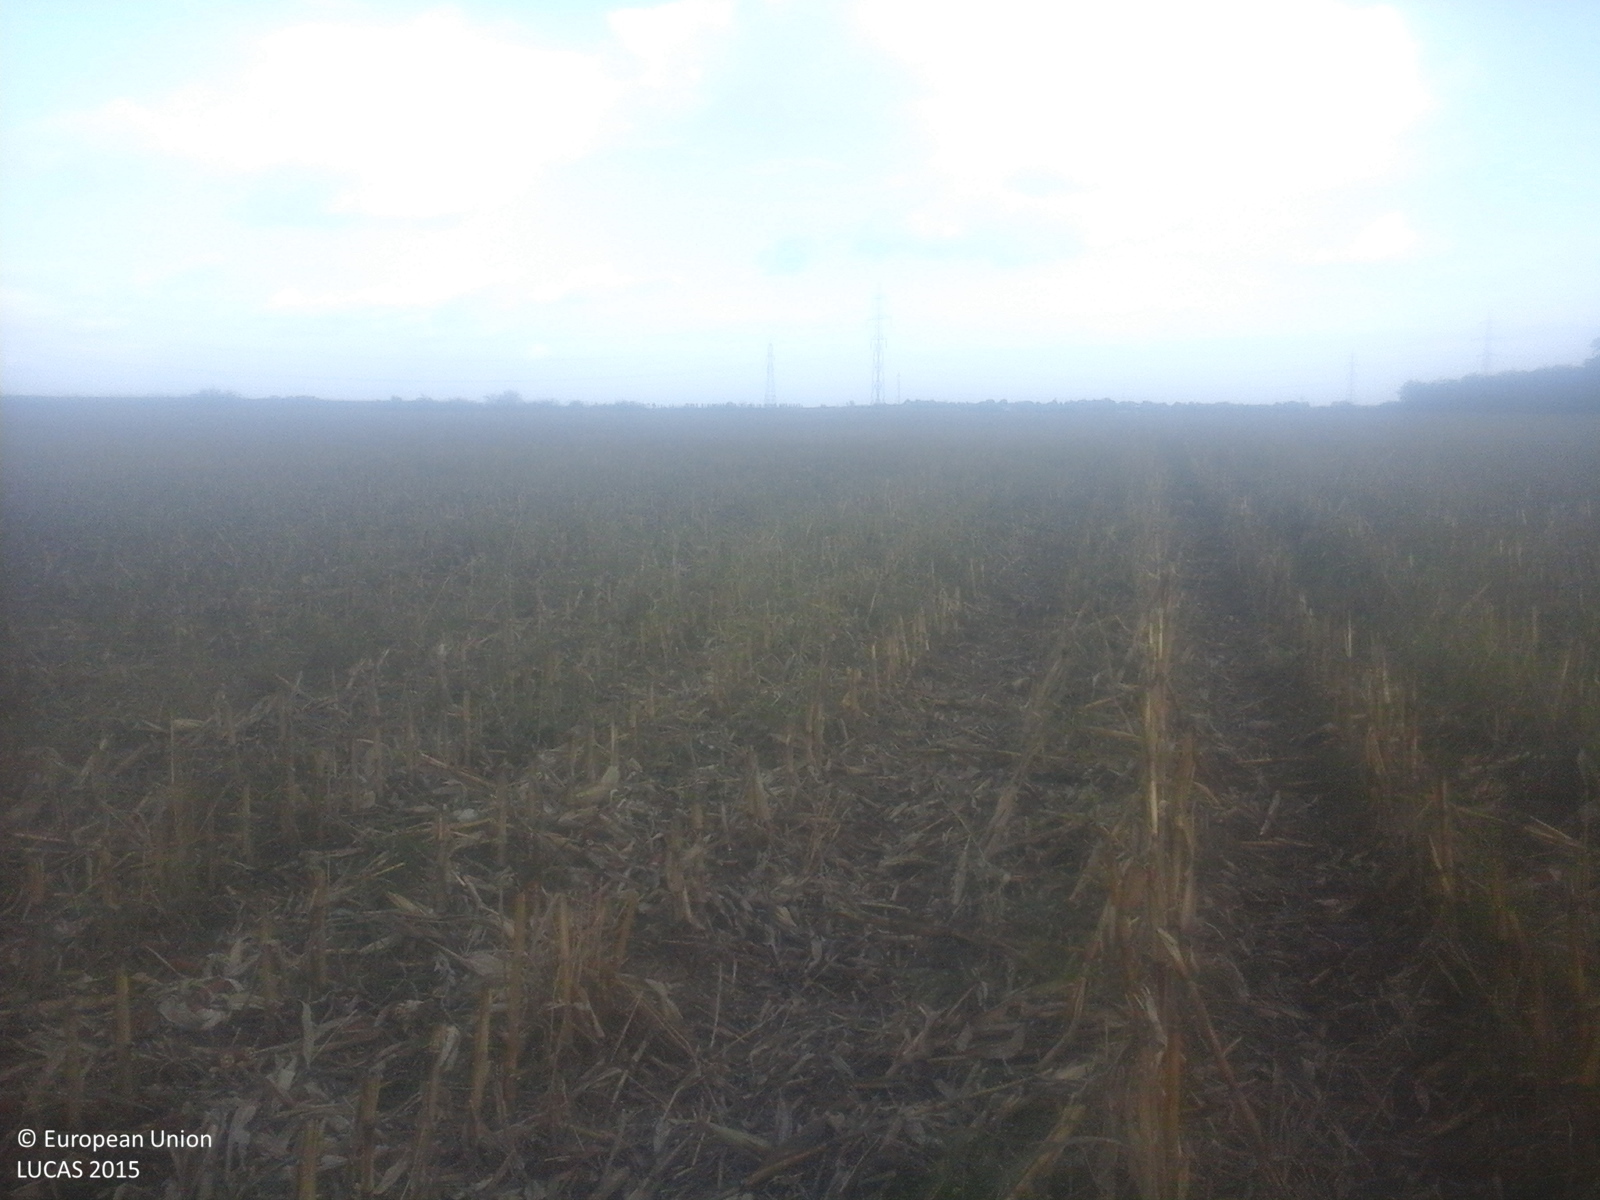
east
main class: Cropland
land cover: Maize
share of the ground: 25 - 50 %
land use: Agriculture (excluding fallow land and kitchen gardens)
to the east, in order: Maize
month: October
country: RO
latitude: 44.7578
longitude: 25.9590
